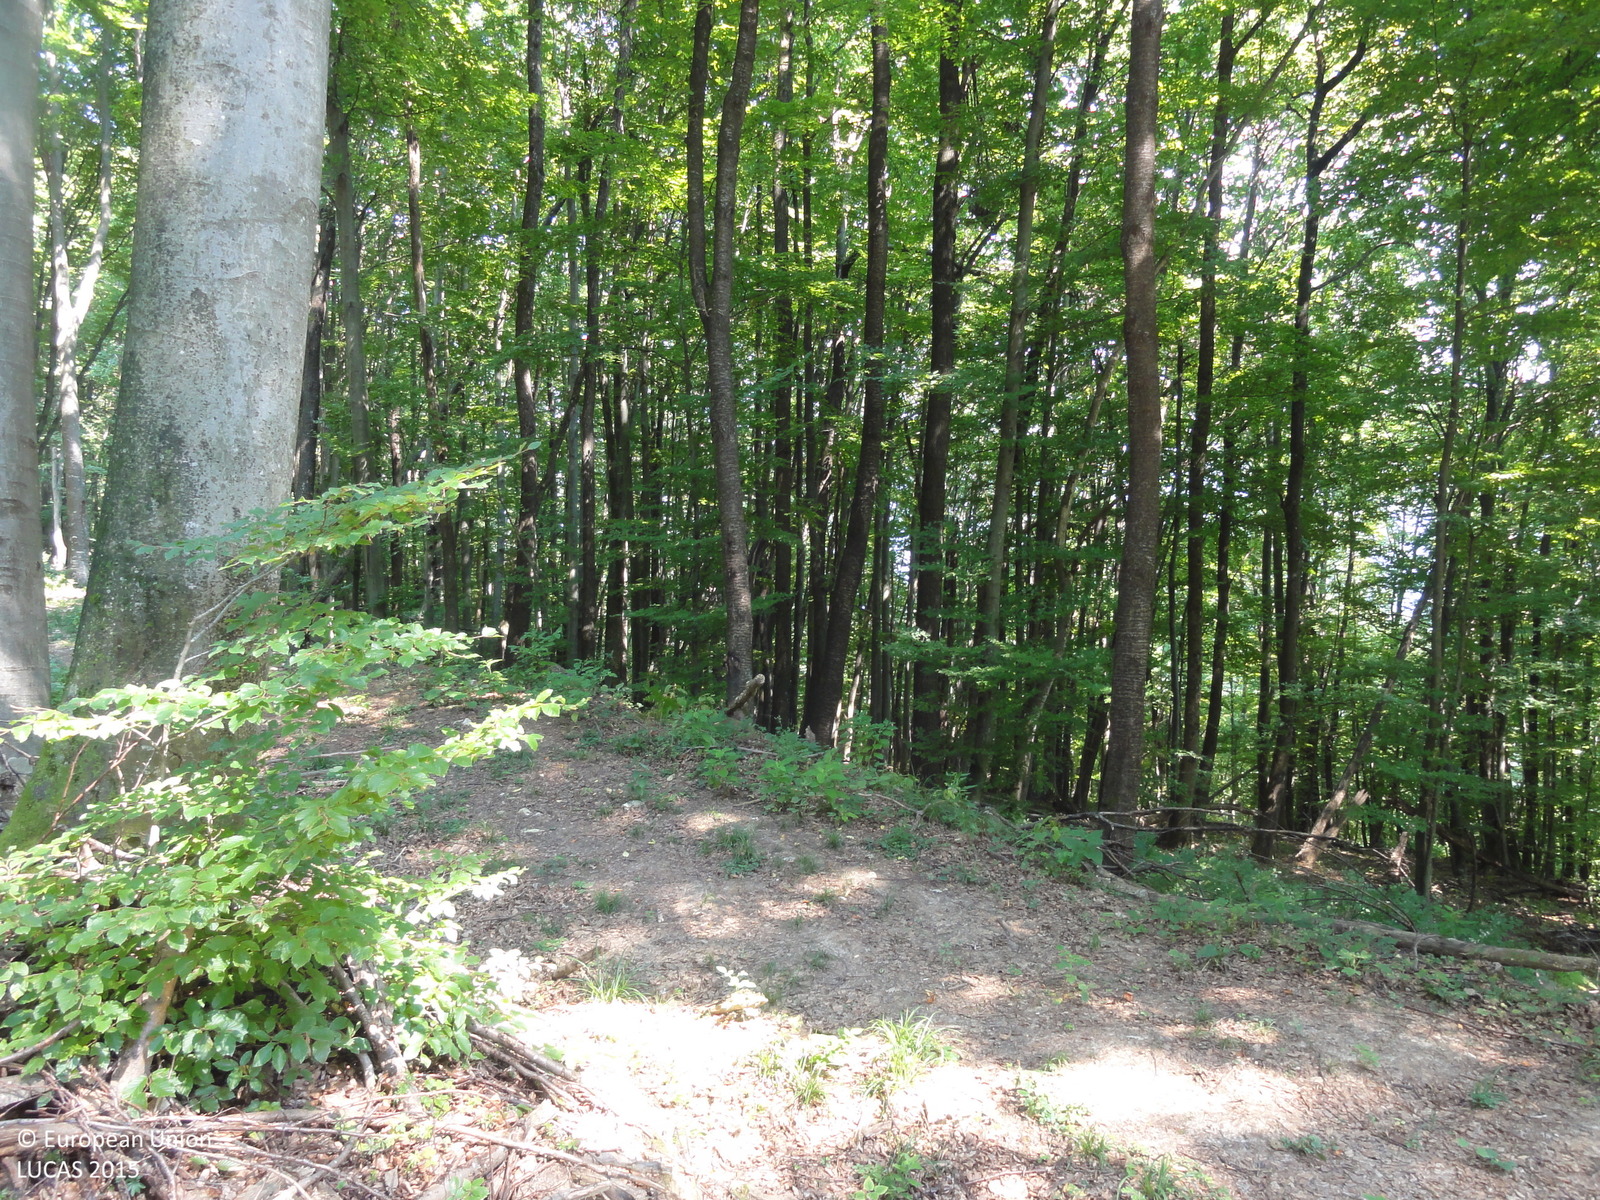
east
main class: Woodland
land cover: Broadleaved woodland
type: beech forest
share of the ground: > 75 %
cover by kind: broadleaved forest trees 90 %, coniferous forest trees 5 %, herbaceous plants 5 %
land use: Forestry
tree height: > 5 m
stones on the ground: < 10 %
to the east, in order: Broadleaved woodland; Tracks; Broadleaved woodland
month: August
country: SI
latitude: 45.7807
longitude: 15.0510
